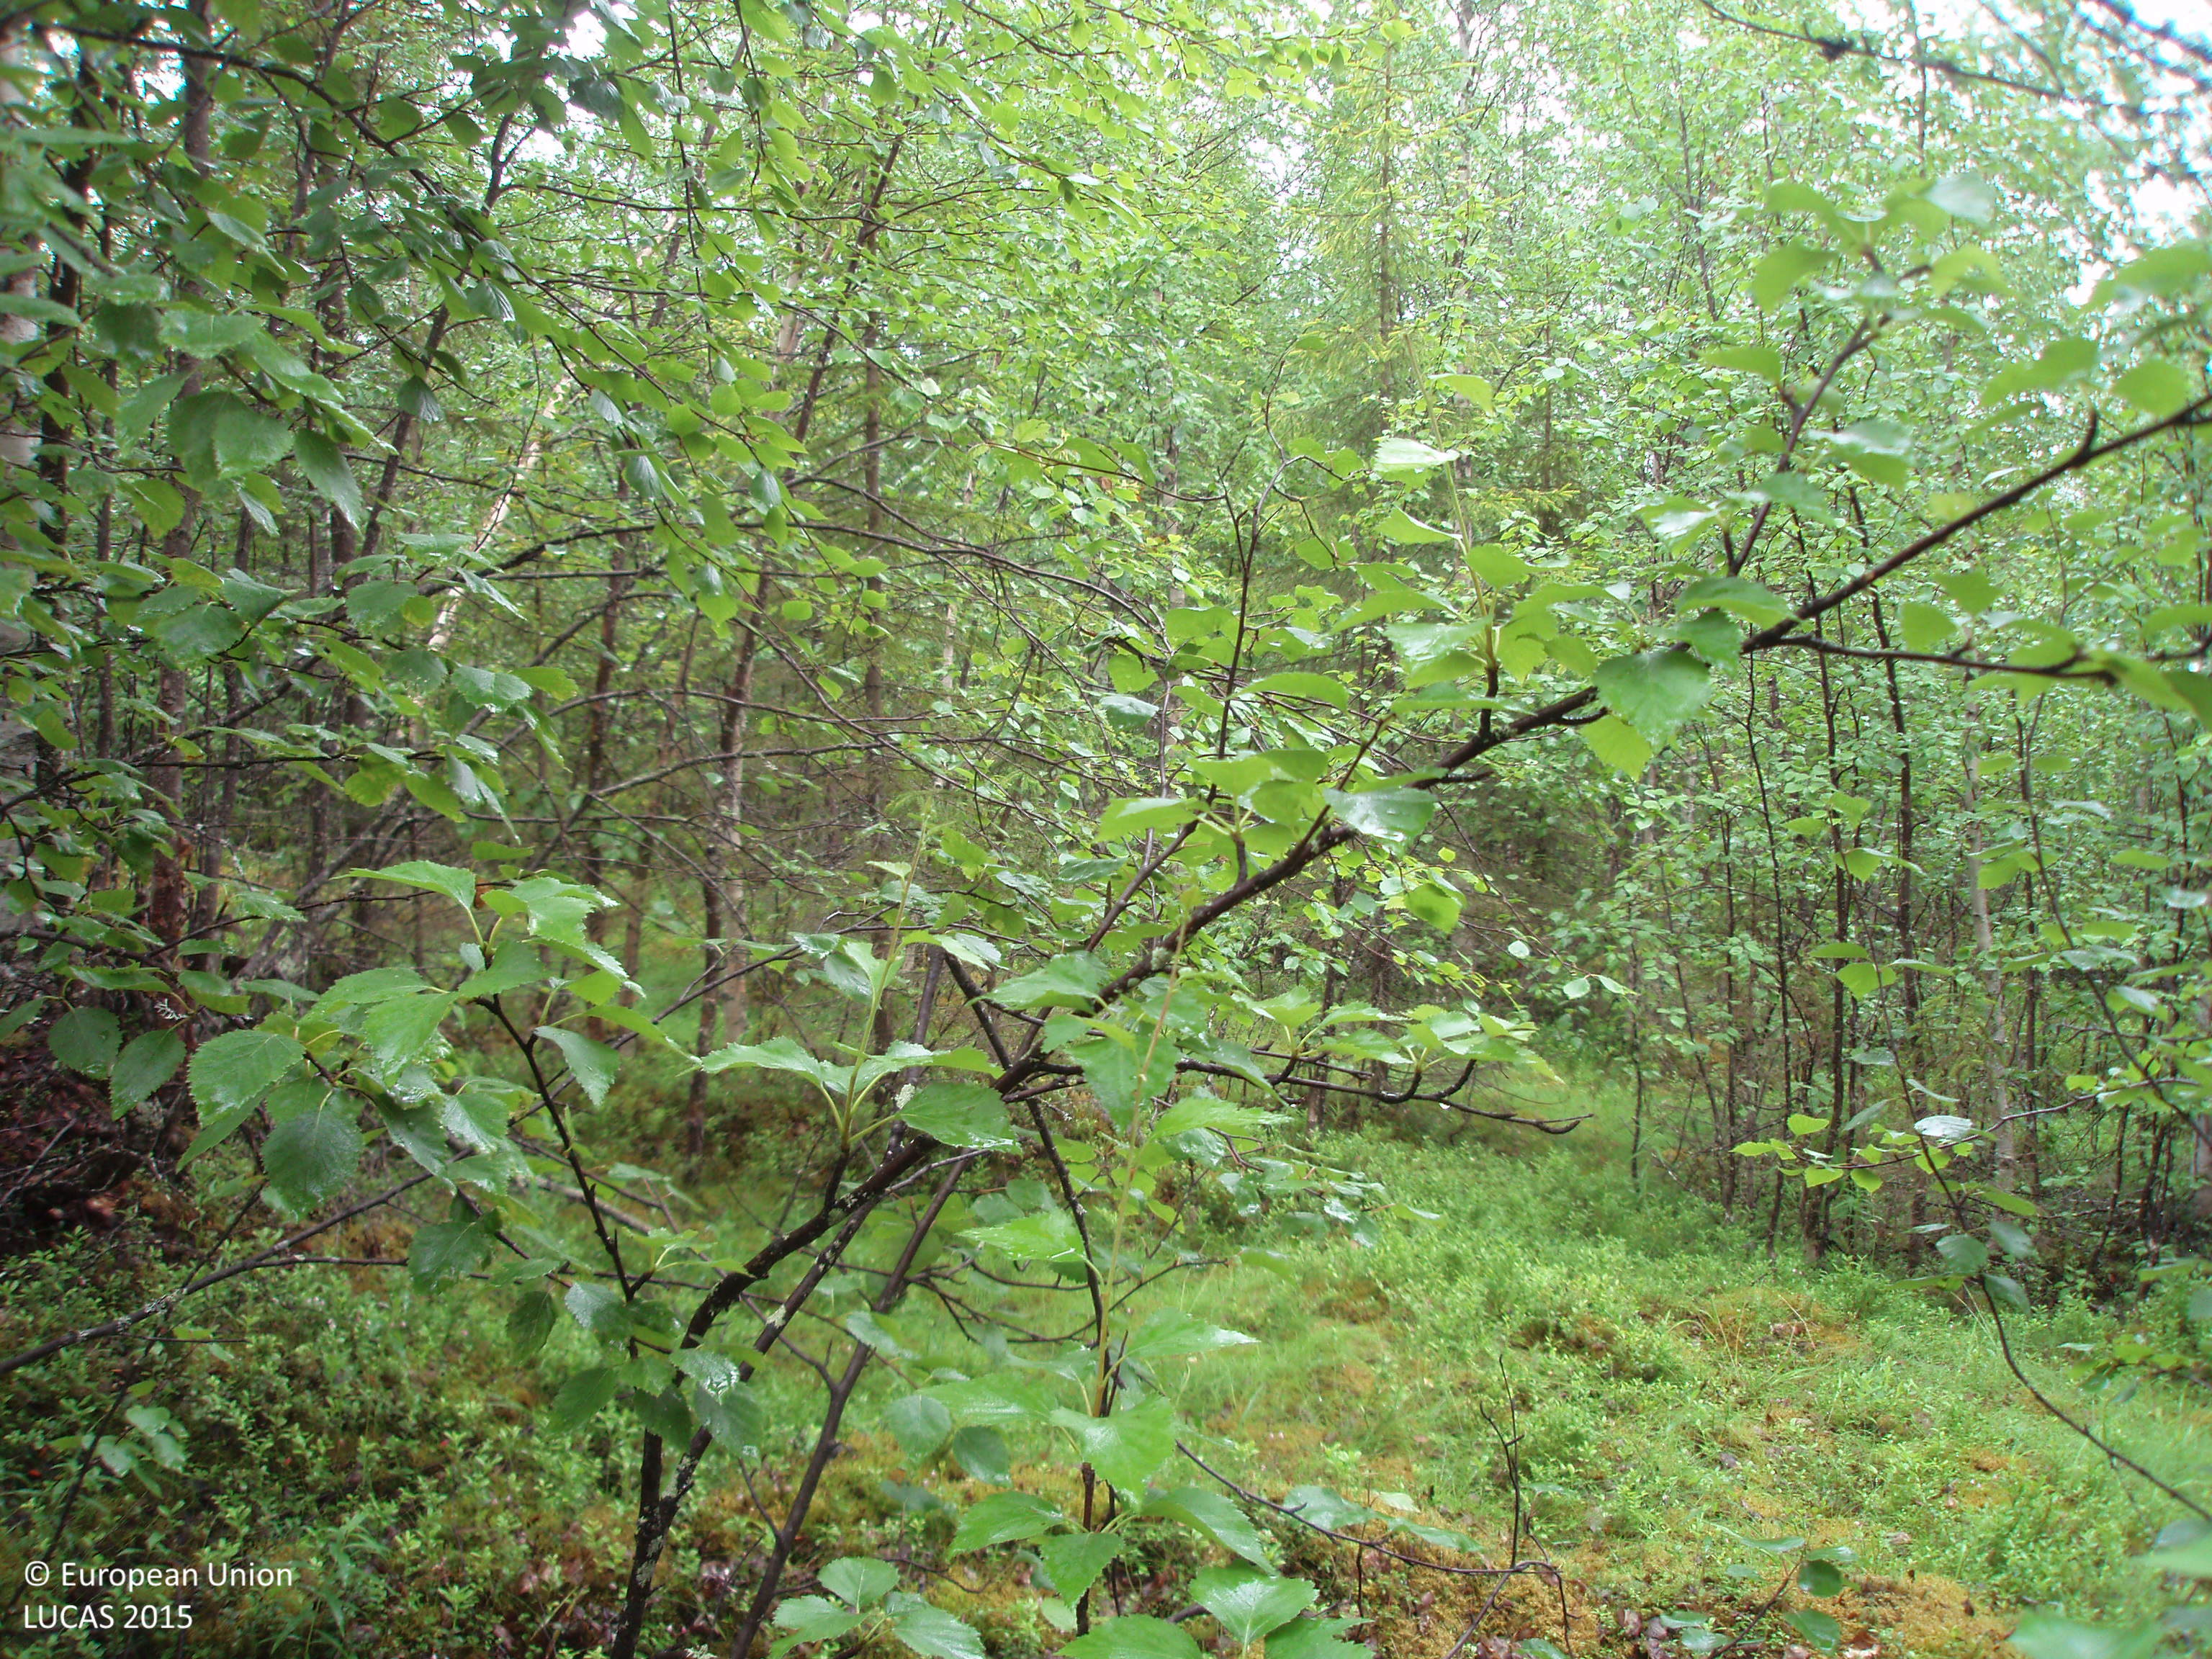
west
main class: Woodland
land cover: Broadleaved woodland
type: boreal forest
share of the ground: > 75 %
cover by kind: broadleaved forest trees 85 %, shrubs 10 %, coniferous forest trees 5 %
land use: Forestry
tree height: > 5 m
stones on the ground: < 10 %
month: July
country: FI
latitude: 66.7039
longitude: 28.2854
